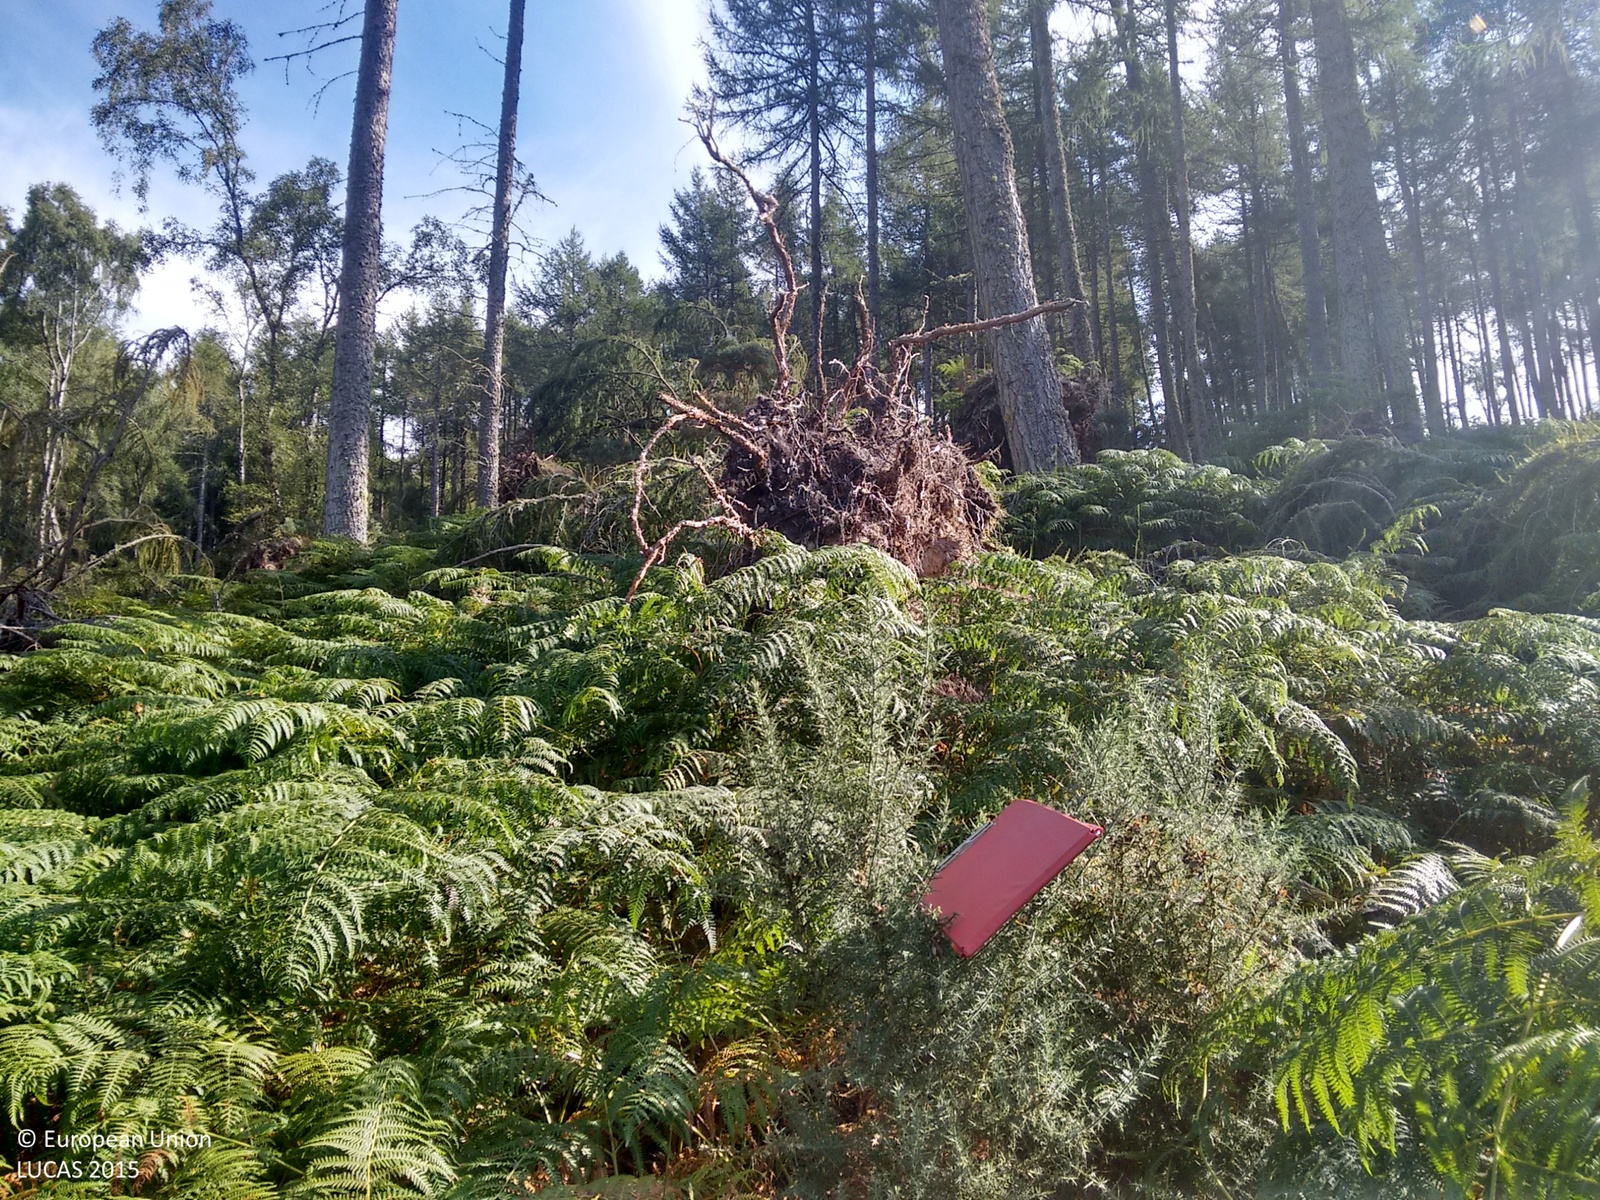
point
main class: Woodland
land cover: Other coniferous woodland
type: exotic forest
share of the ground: > 75 %
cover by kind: herbaceous plants 65 %, coniferous forest trees 30 %, shrubs 5 %
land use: Forestry
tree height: > 5 m
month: September
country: GB
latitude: 57.4139
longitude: -4.2876
